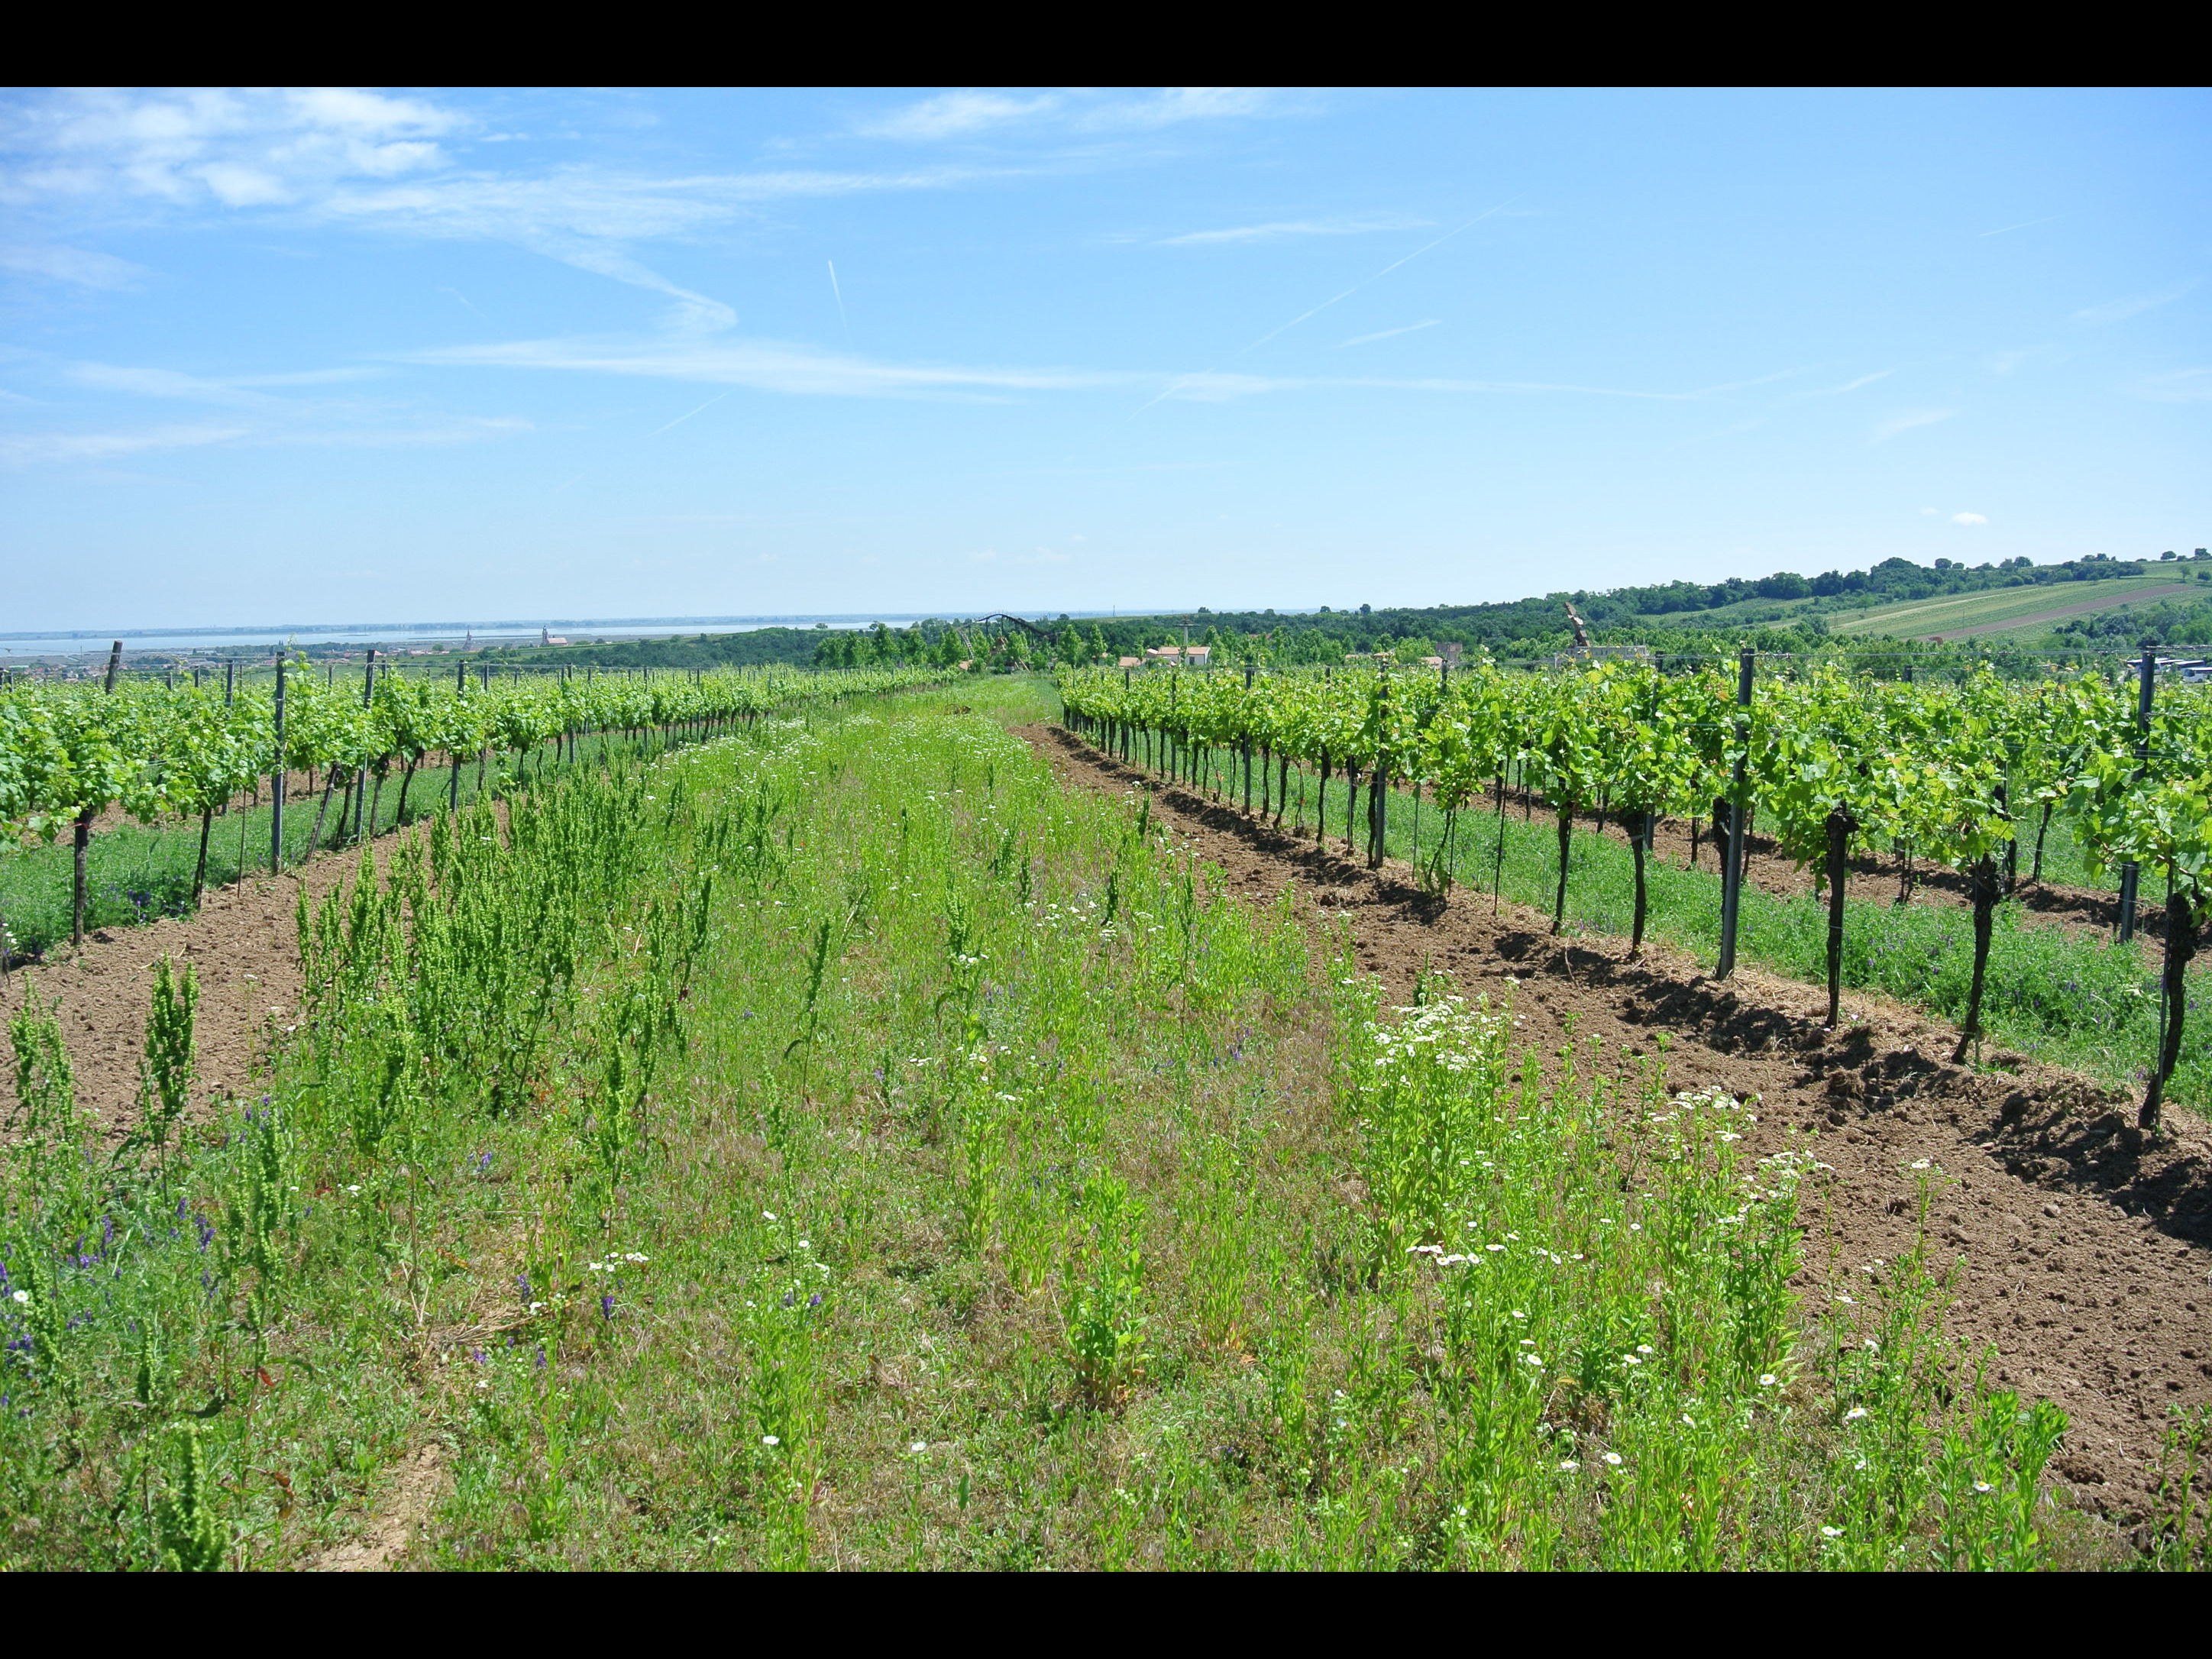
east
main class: Cropland
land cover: Temporary grasslands
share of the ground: > 75 %
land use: Agriculture (excluding fallow land and kitchen gardens)
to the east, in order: Temporary grasslands; Other bare soil; Vineyards; Grass margins; Paved roads, cycling and walking lanes; Grass margins; Temporary grasslands; Vineyards
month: June
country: AT
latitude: 47.8066
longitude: 16.6415
